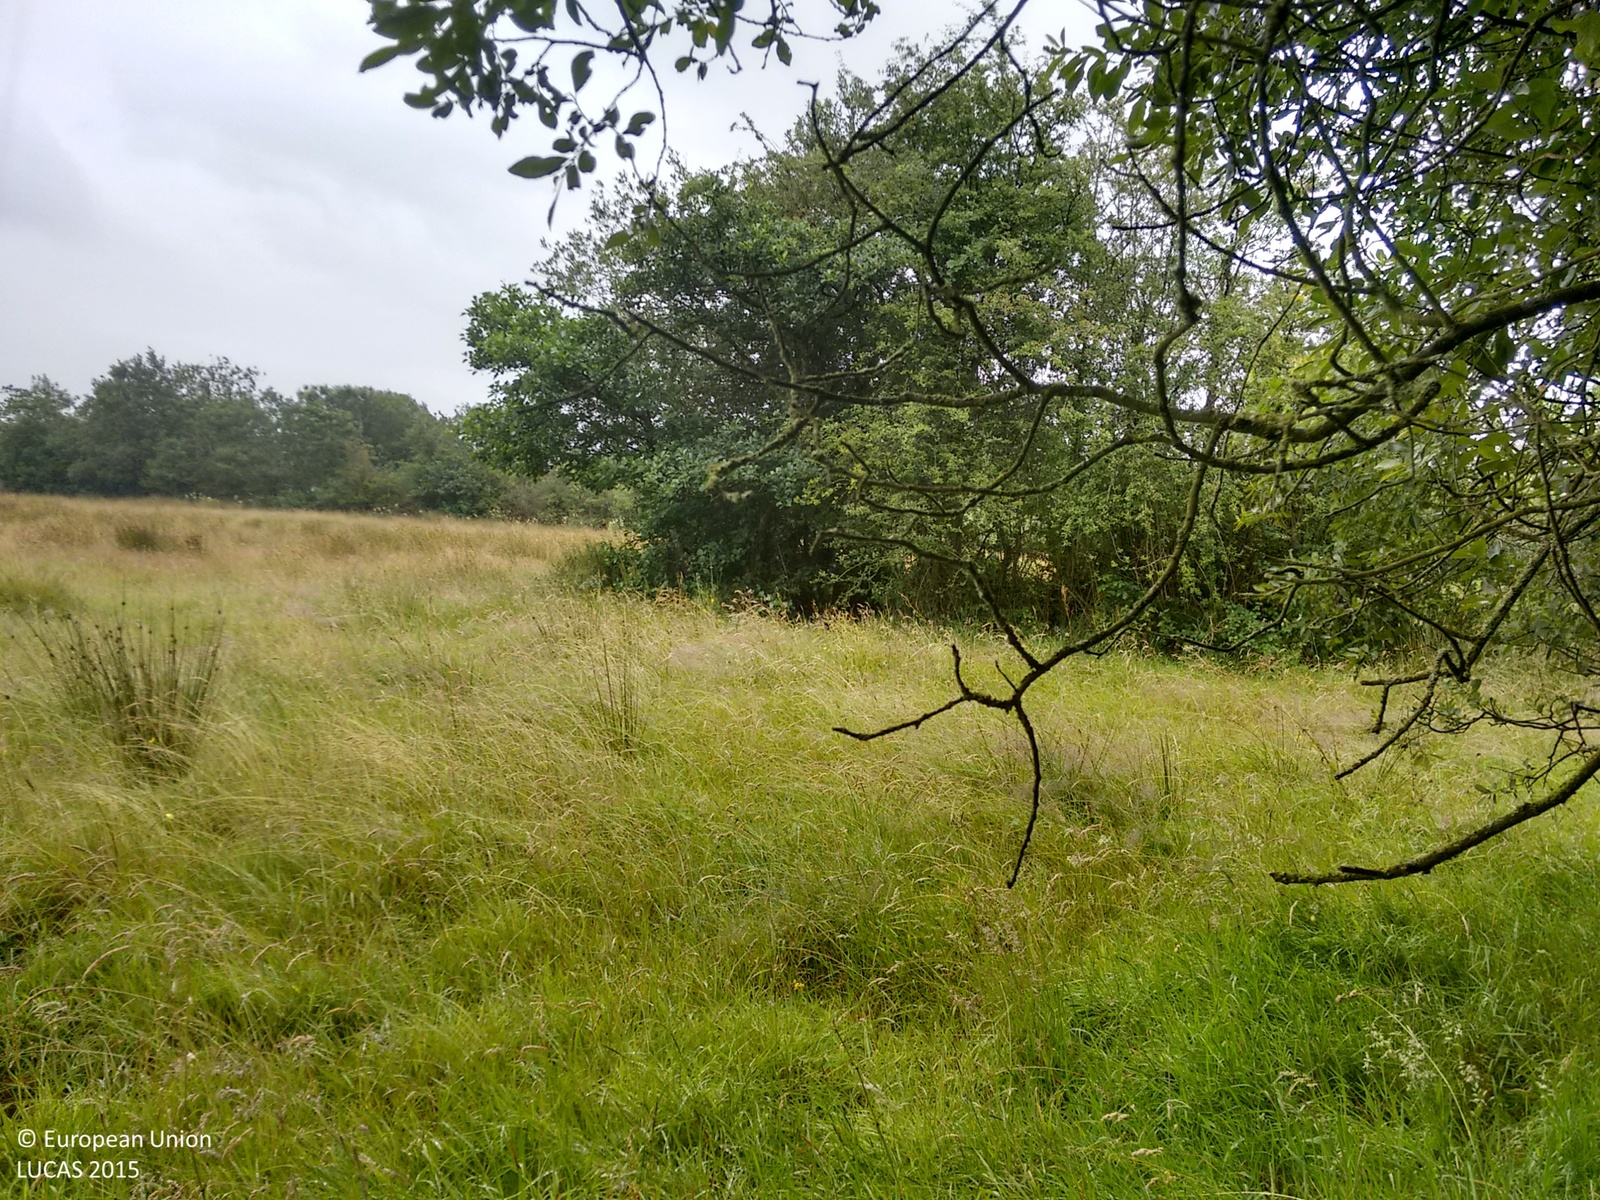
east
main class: Woodland
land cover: Broadleaved woodland
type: exotic forest
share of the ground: > 75 %
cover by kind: broadleaved forest trees 80 %, shrubs 15 %, herbaceous plants 5 %
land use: Semi-natural and natural areas not in use
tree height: > 5 m
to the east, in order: Broadleaved woodland; Grassland without tree/shrub cover; Single bushes/trees; Abandoned hedges; Grassland without tree/shrub cover; Fences; Abandoned hedges; Grassland without tree/shrub cover; Abandoned hedges; Fences; Grassland without tree/shrub cover; Abandoned hedges; Fences; Grassland without tree/shrub cover
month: August
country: GB
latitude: 54.6437
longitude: -6.5350
